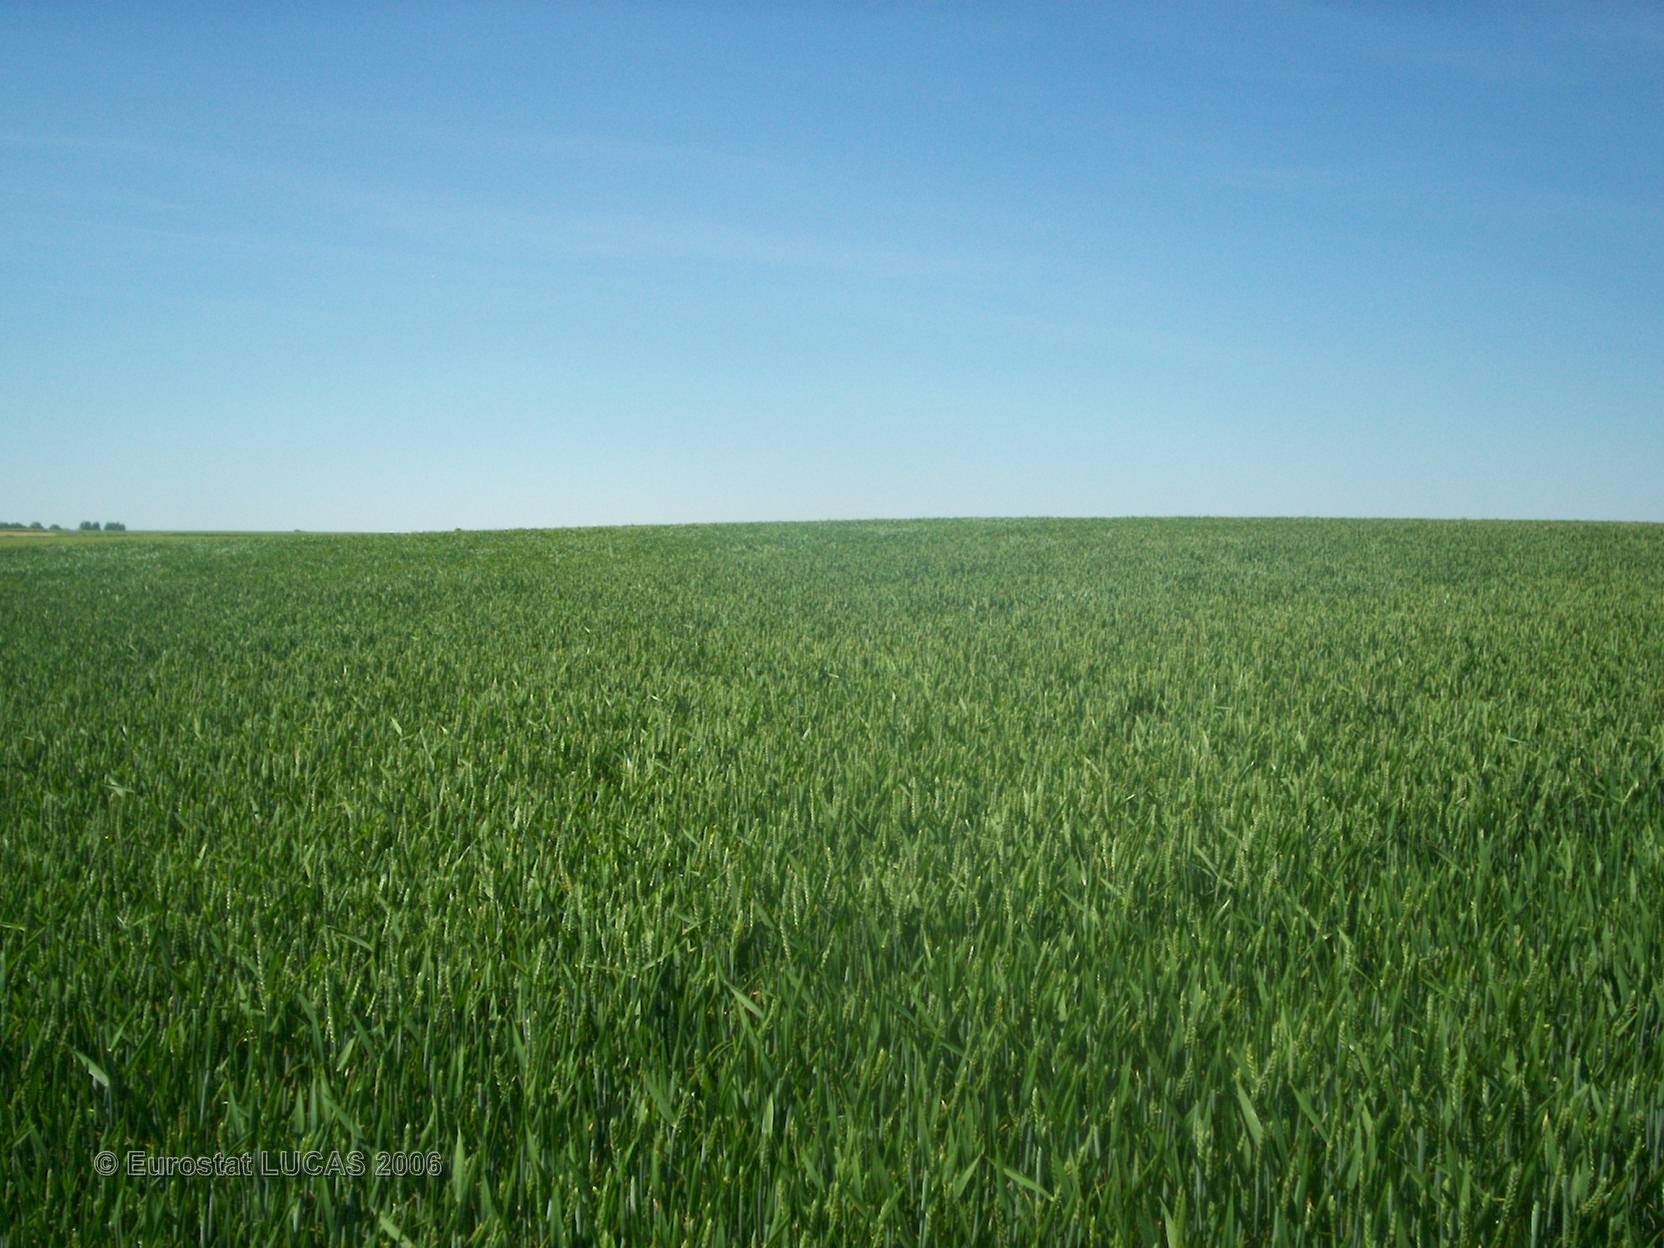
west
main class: Cropland
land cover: Common wheat
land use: Agriculture (excluding fallow land and kitchen gardens)
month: June
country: FR
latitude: 50.2522
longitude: 2.6251
